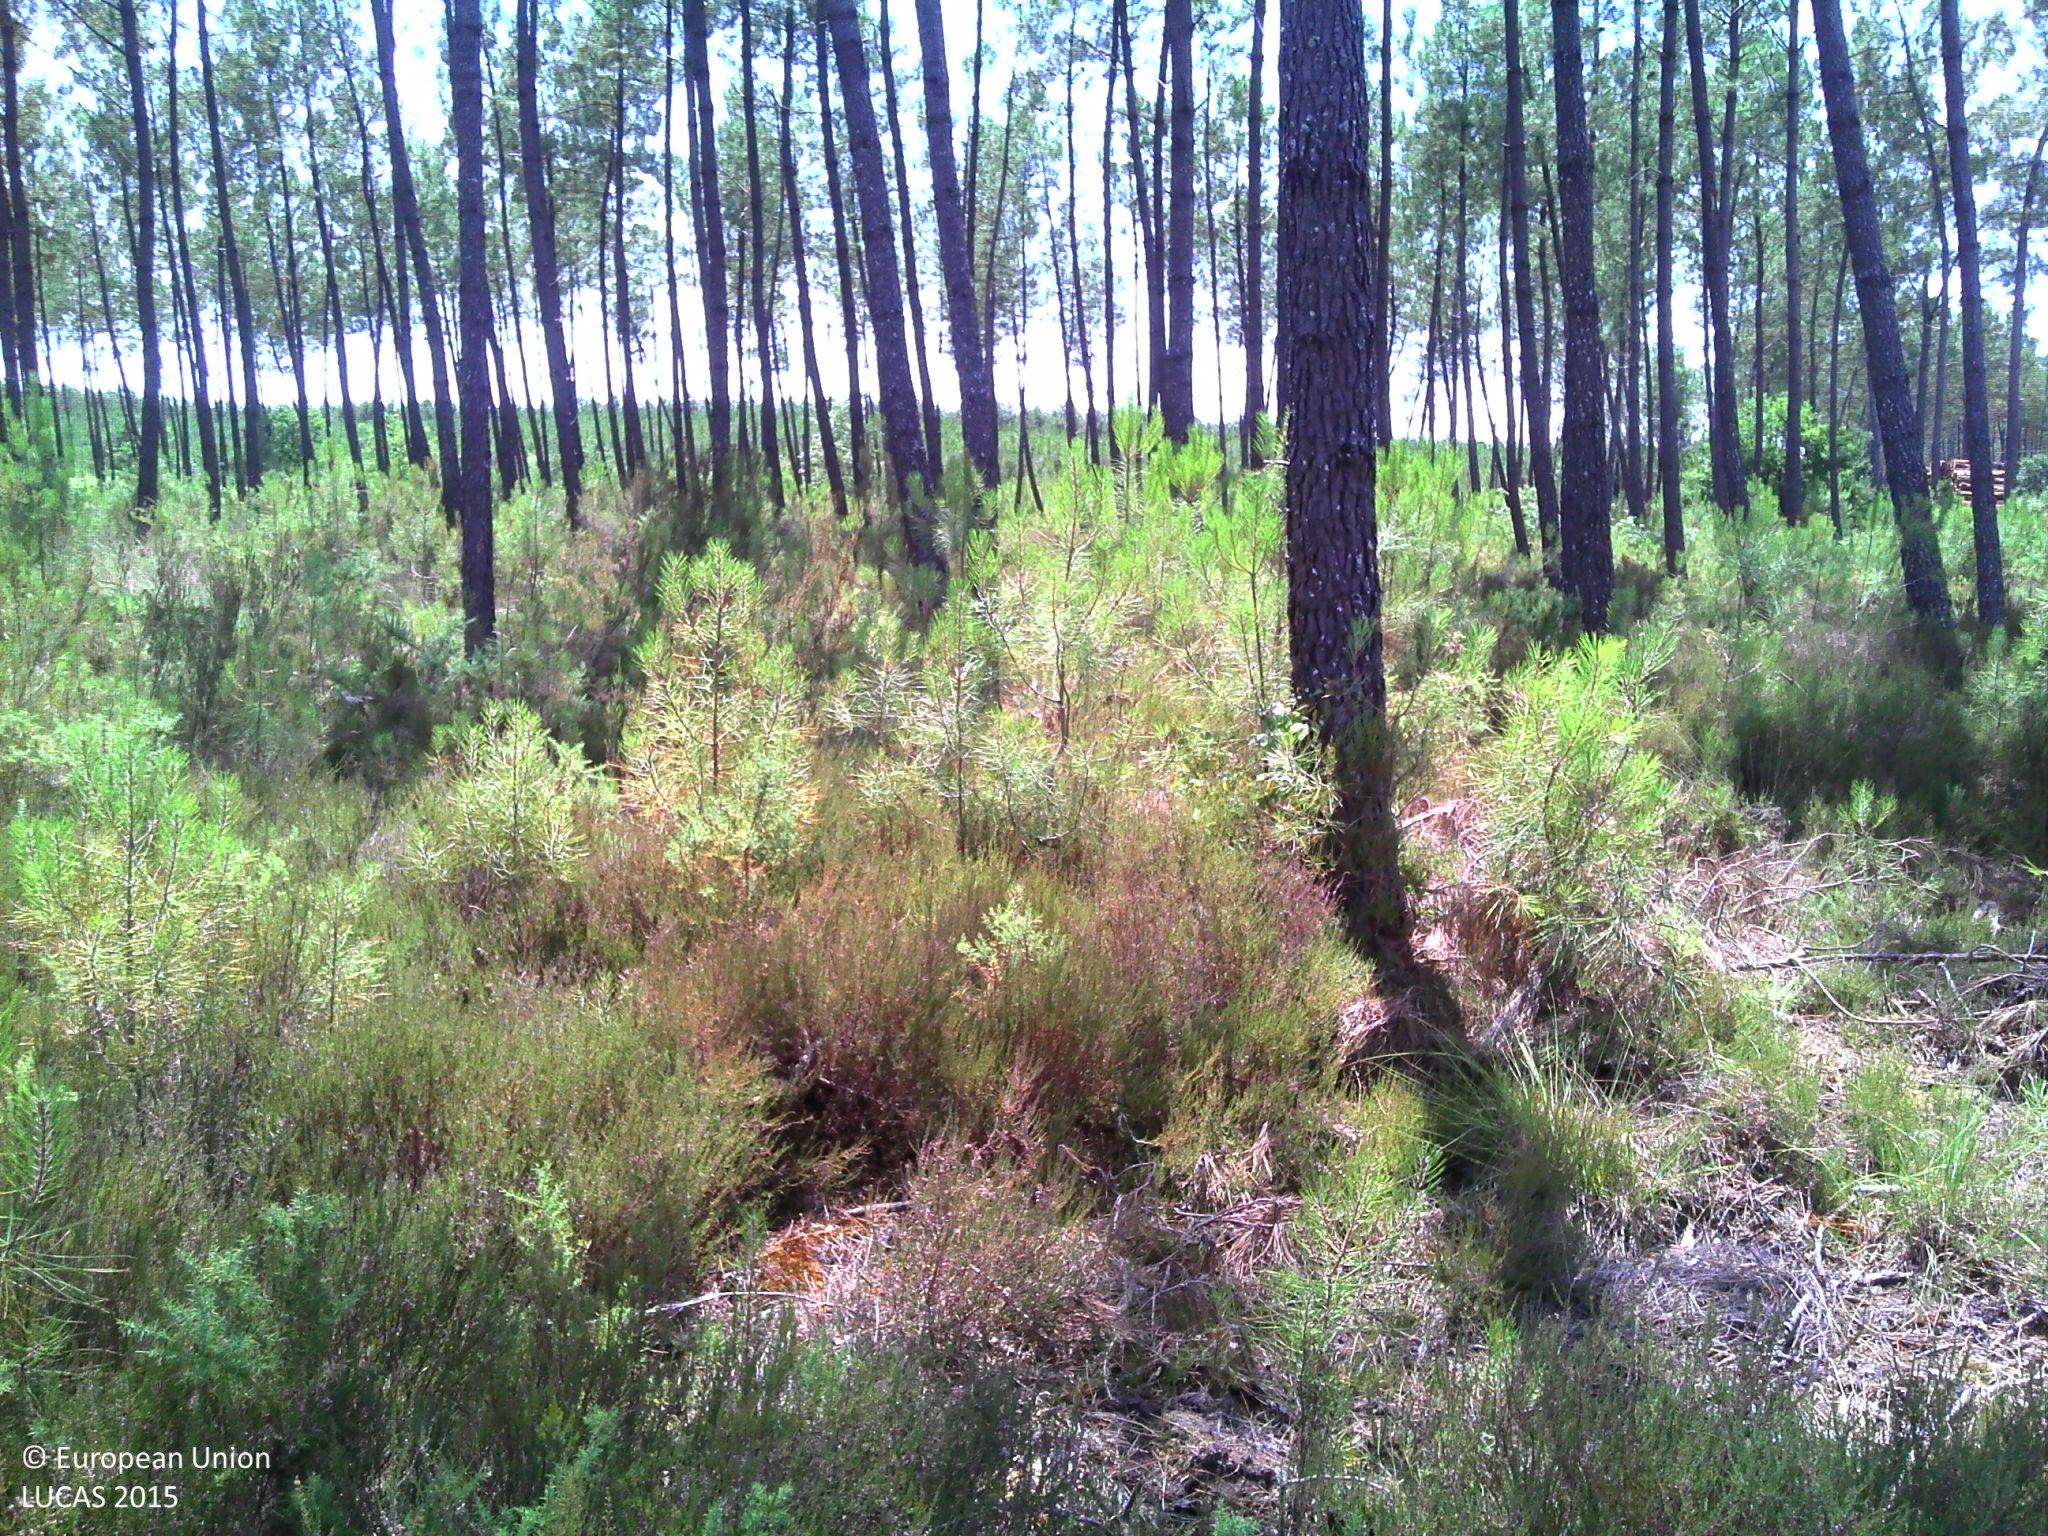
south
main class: Woodland
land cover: Pine dominated coniferous woodland
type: coniferous forest of the mediterranean region
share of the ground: > 75 %
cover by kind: coniferous forest trees 80 %, herbaceous plants 20 %
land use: Forestry
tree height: > 5 m
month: July
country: FR
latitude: 44.3498
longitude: -0.6162
